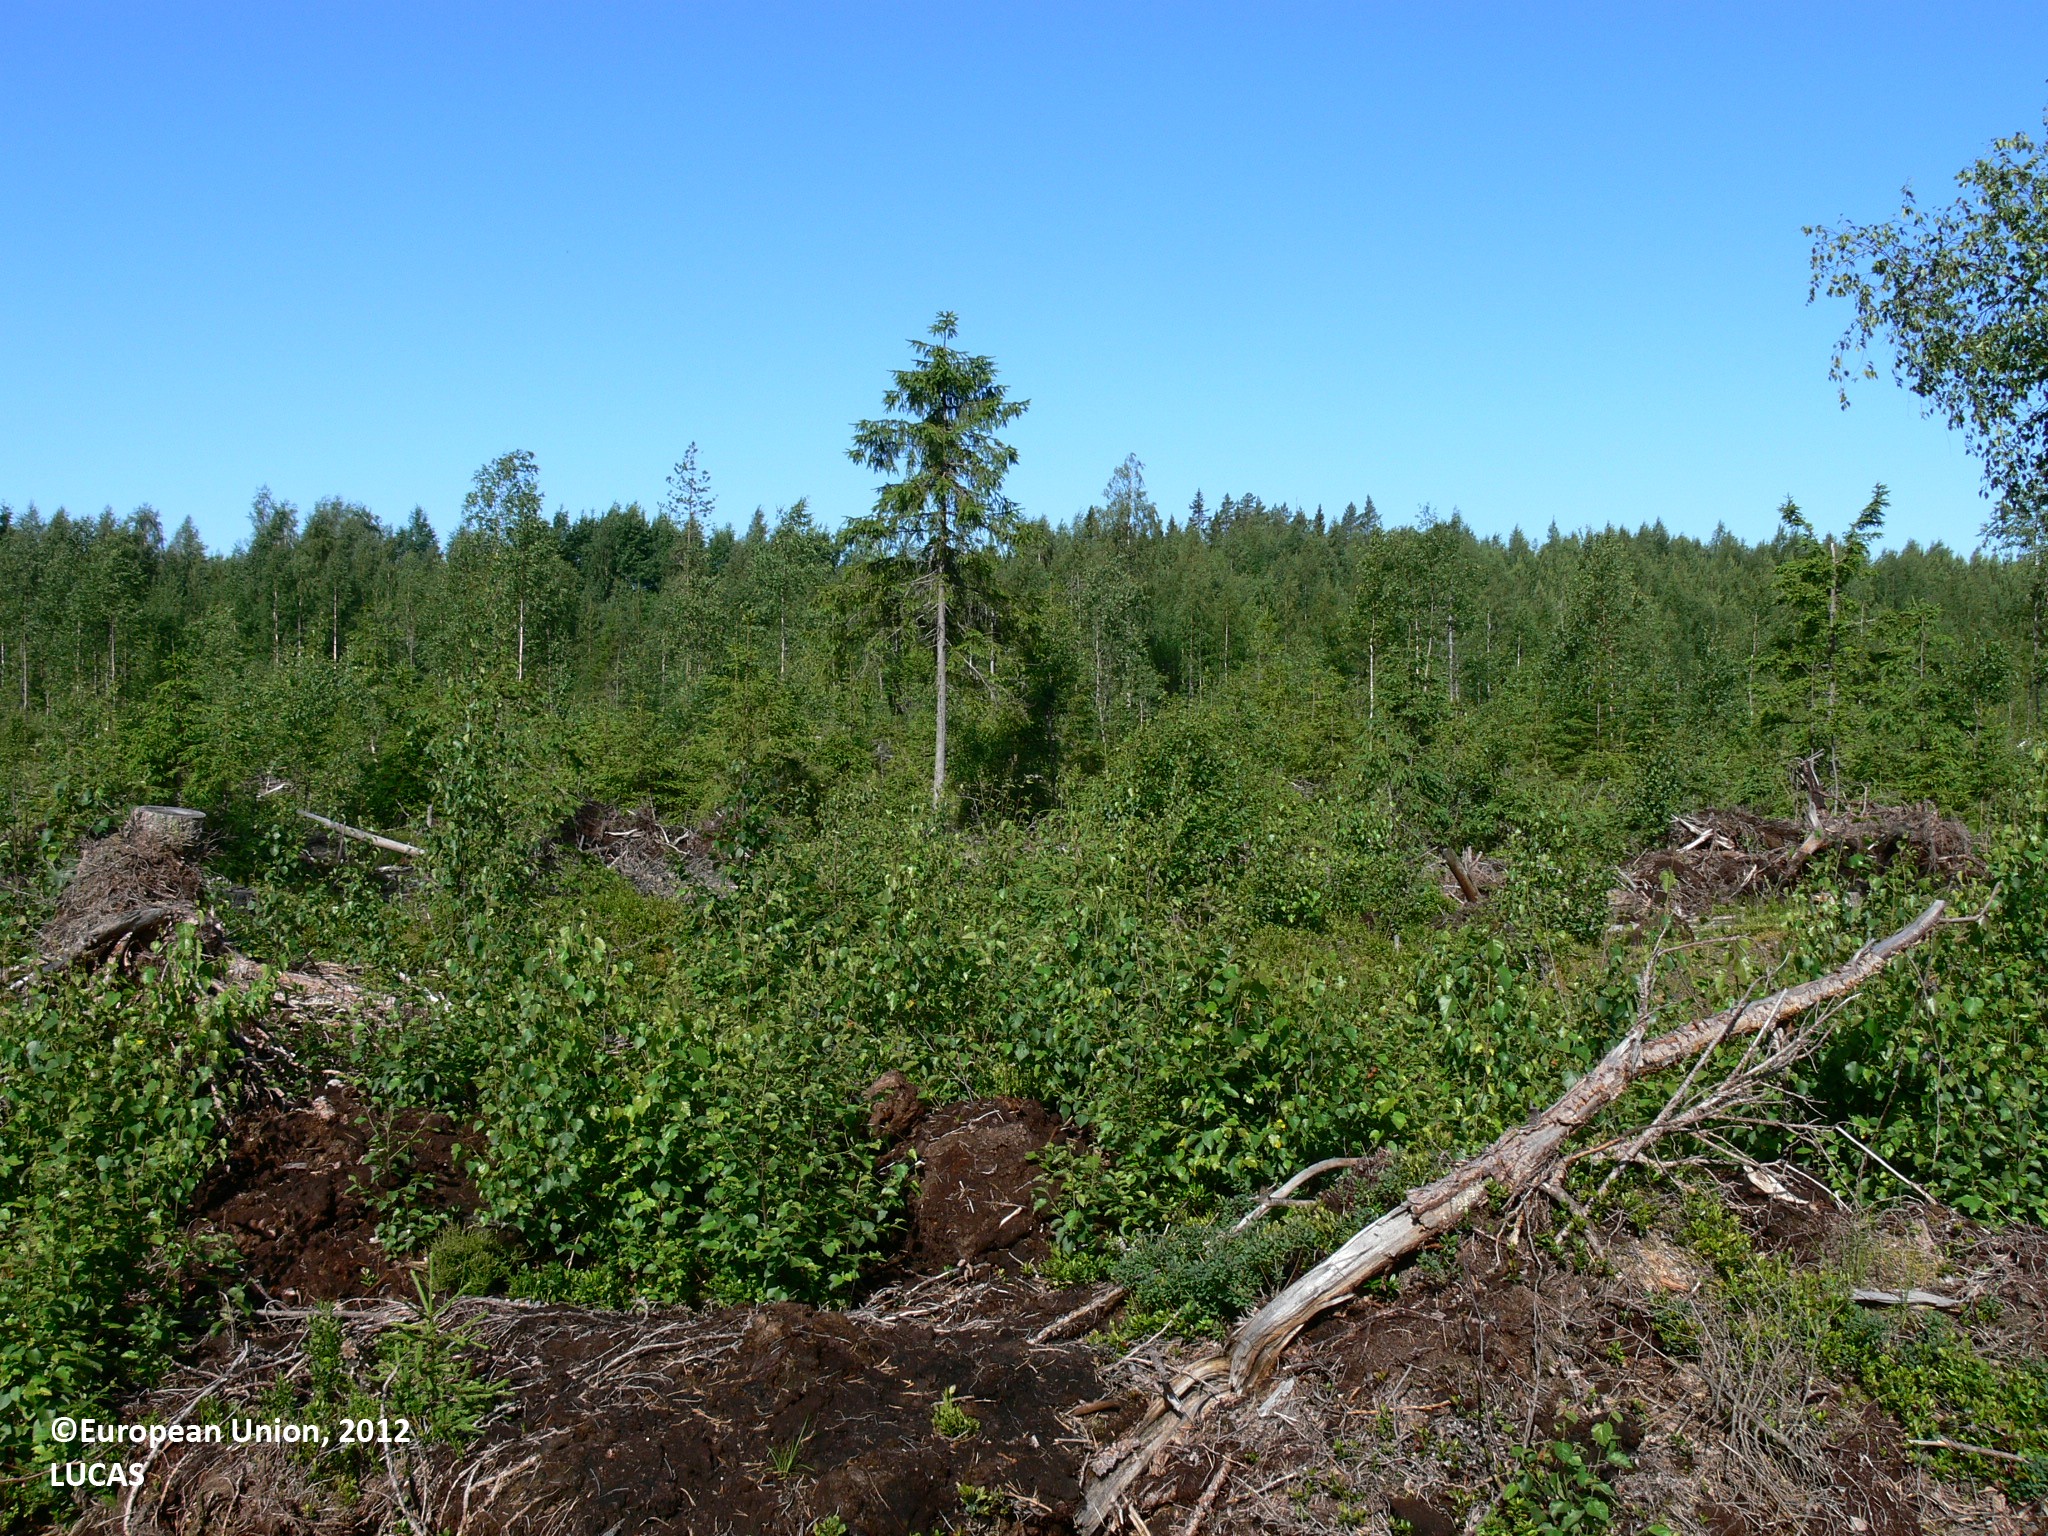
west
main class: Woodland
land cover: Broadleaved woodland
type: boreal forest
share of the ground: 10 - 25 %
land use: Forestry
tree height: < 5 m
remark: Clear cut
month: July
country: FI
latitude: 62.8896
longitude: 29.9013
